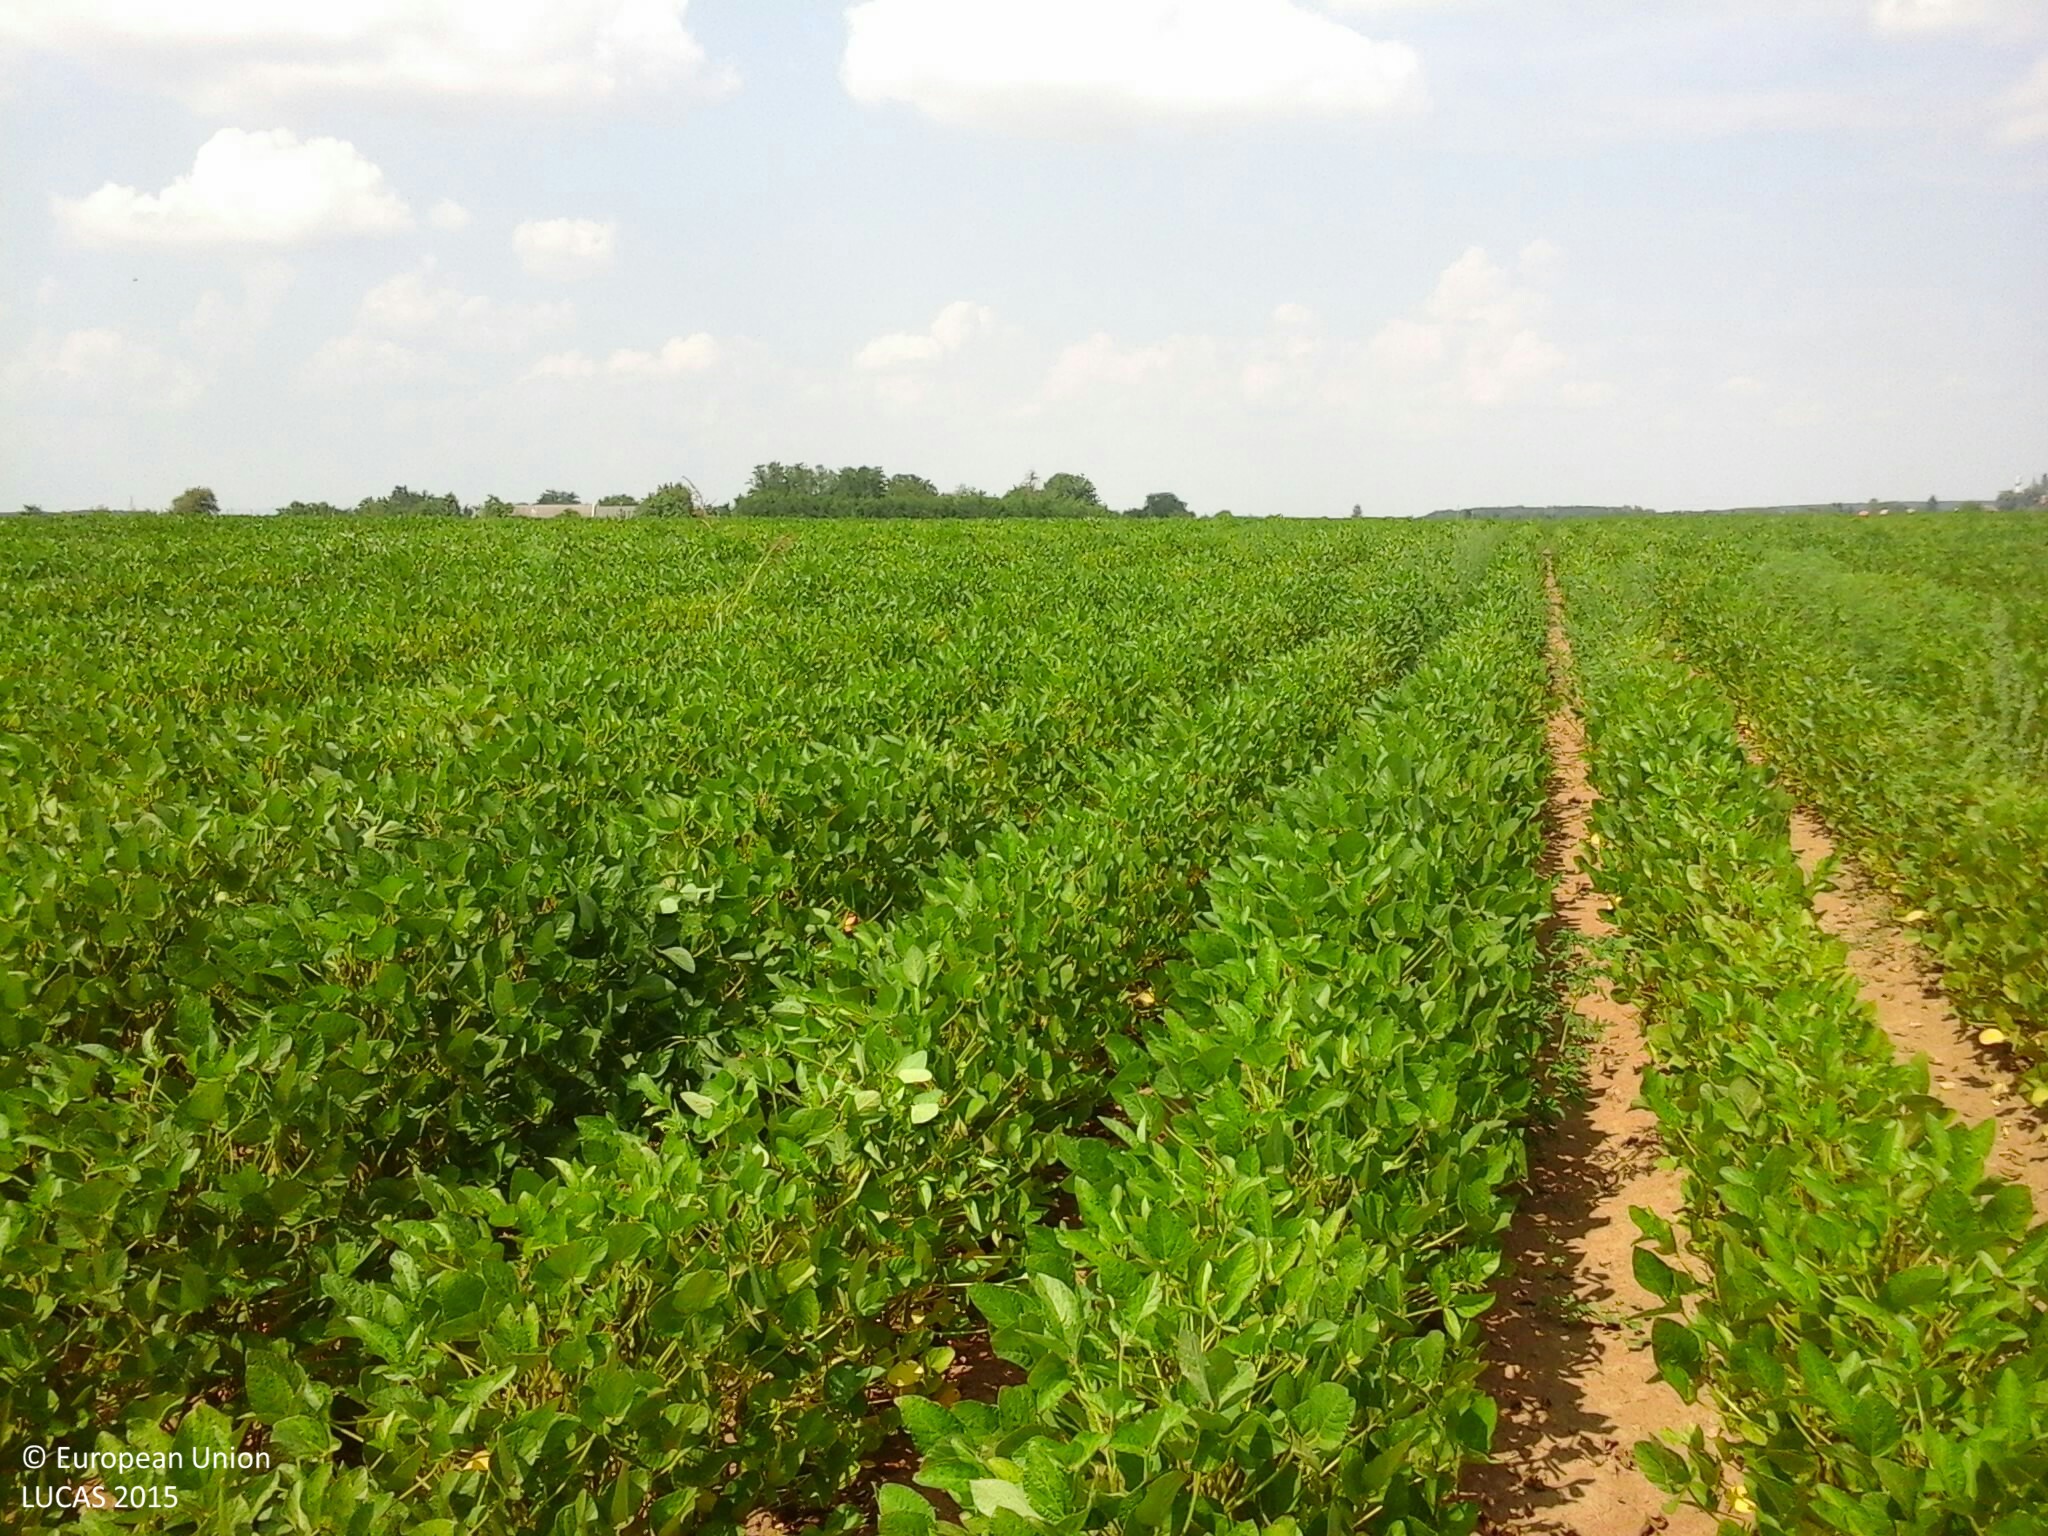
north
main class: Cropland
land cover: Soya
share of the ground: > 75 %
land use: Agriculture (excluding fallow land and kitchen gardens)
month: August
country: HU
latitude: 45.9099
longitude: 18.1924
